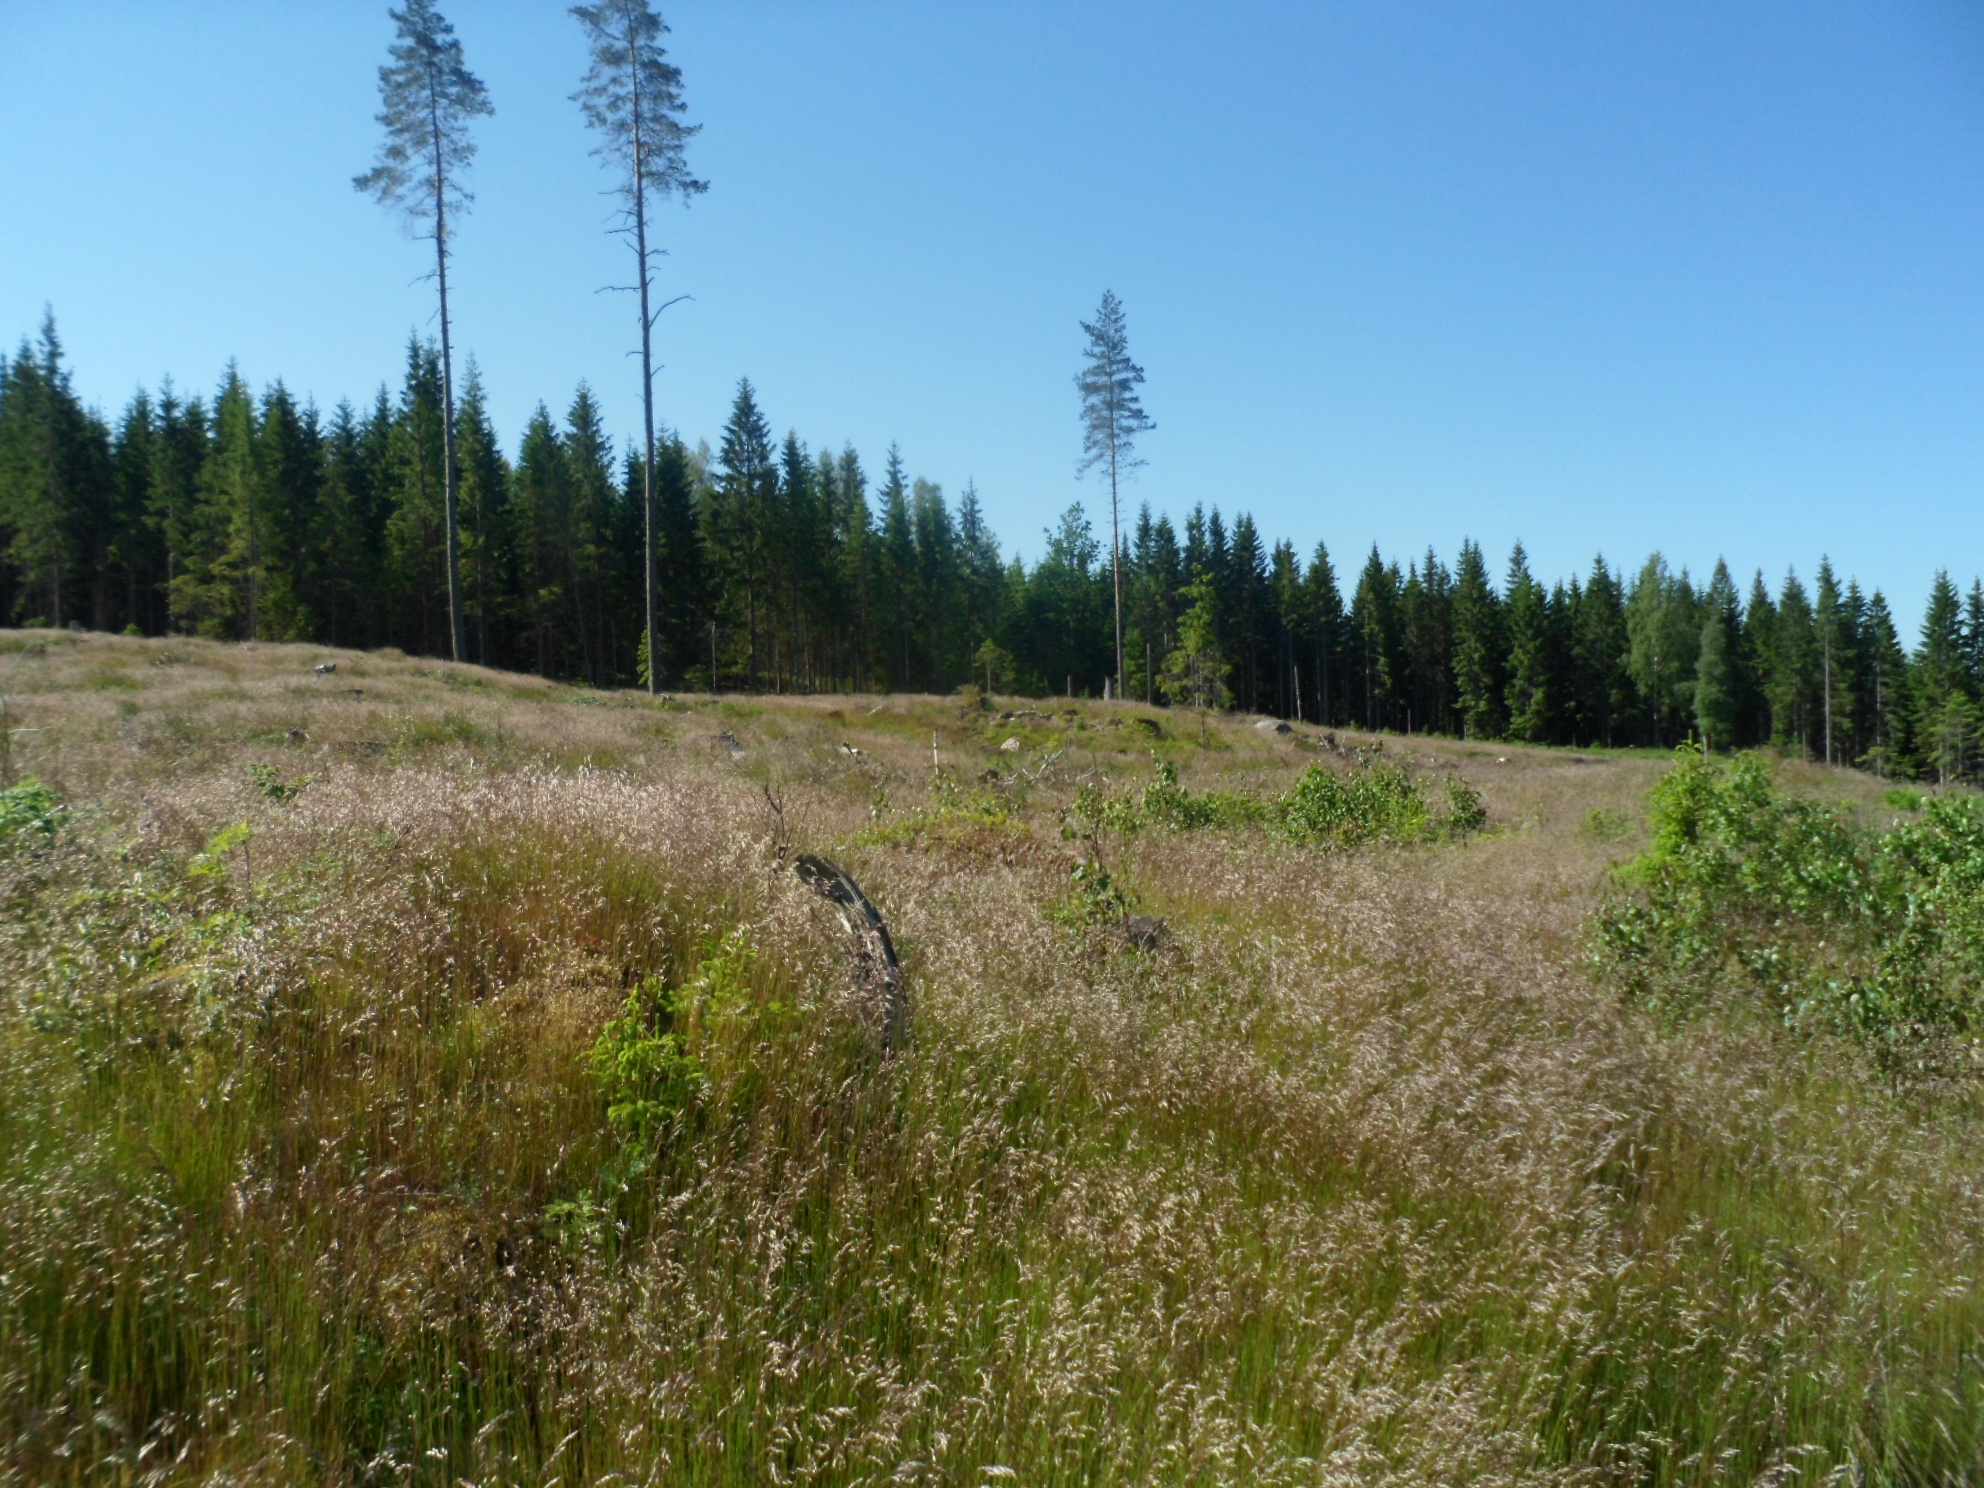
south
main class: Grassland
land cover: Grassland with sparse tree/shrub cover
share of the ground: > 75 %
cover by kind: herbaceous plants 85 %, coniferous forest trees 5 %, shrubs 5 %, lichens and mosses 5 %
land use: Forestry
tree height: < 5 m
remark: Clear cut
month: July
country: SE
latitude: 57.4581
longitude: 14.5462
